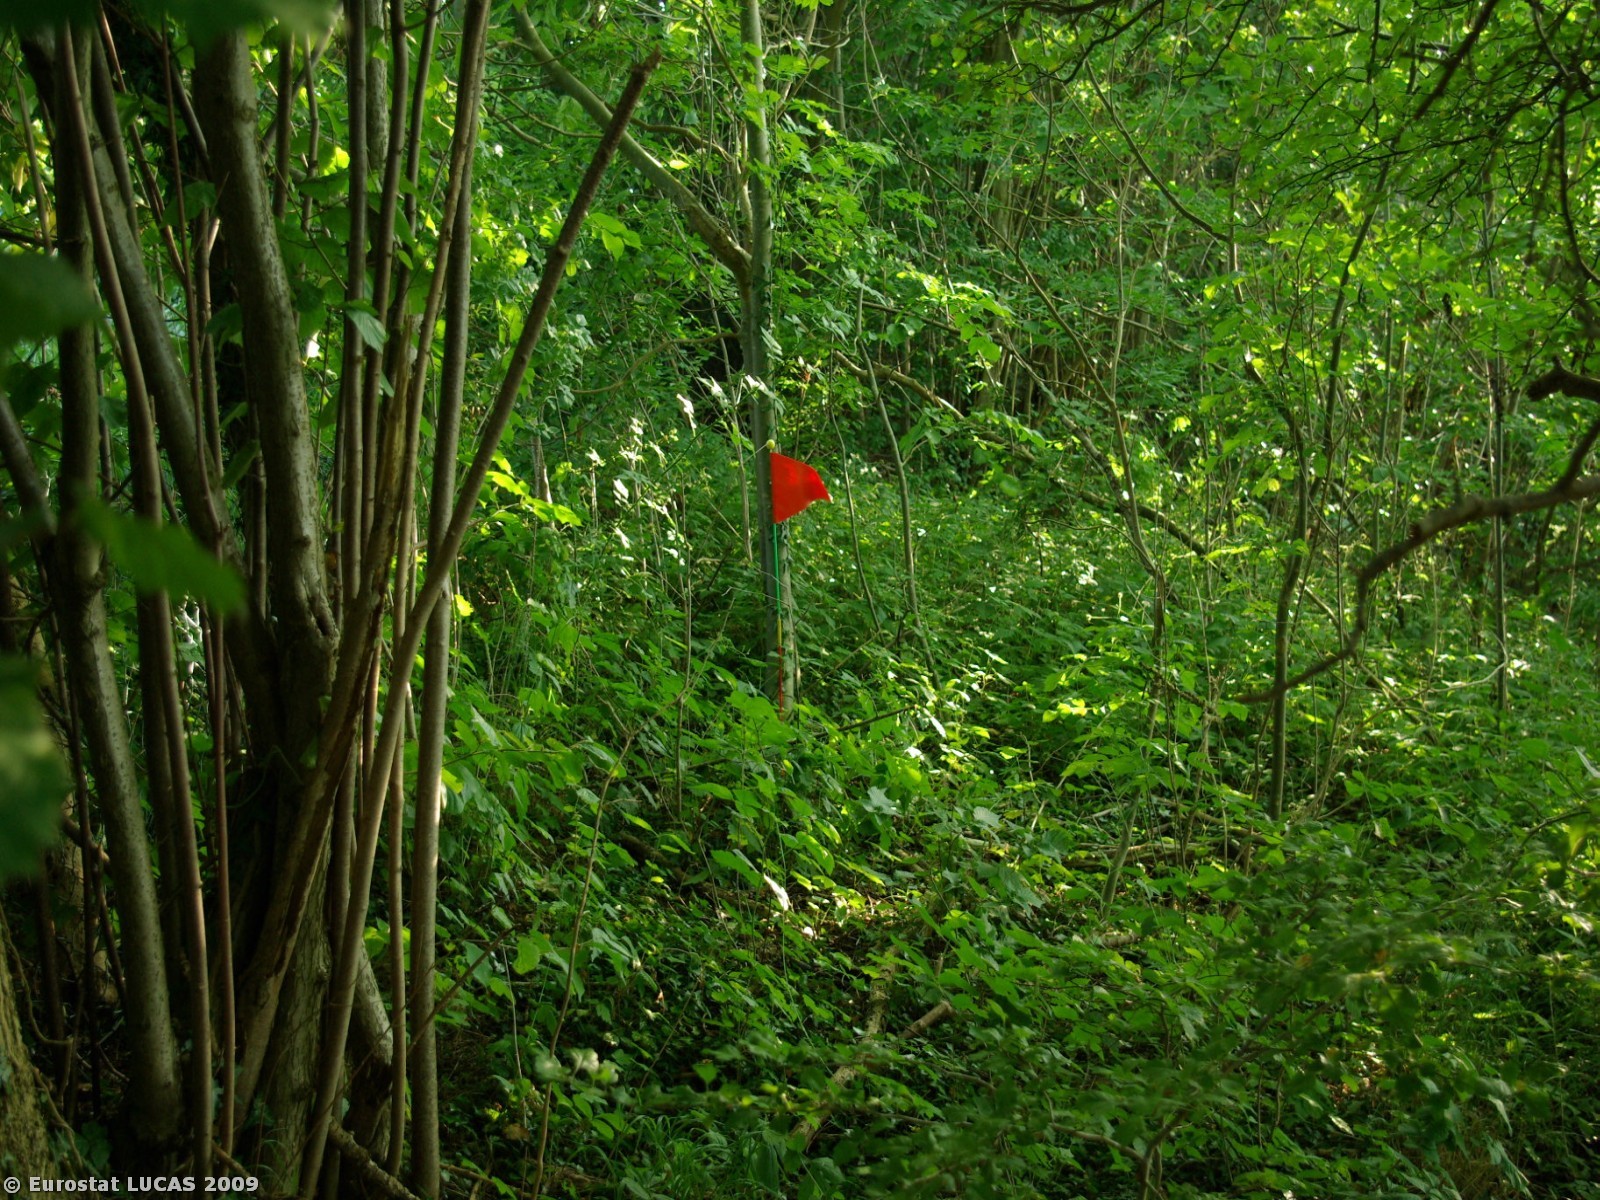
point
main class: Woodland
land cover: Broadleaved woodland
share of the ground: > 75 %
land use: Unused
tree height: > 5 m
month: July
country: DK
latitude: 54.9475
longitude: 9.8908
